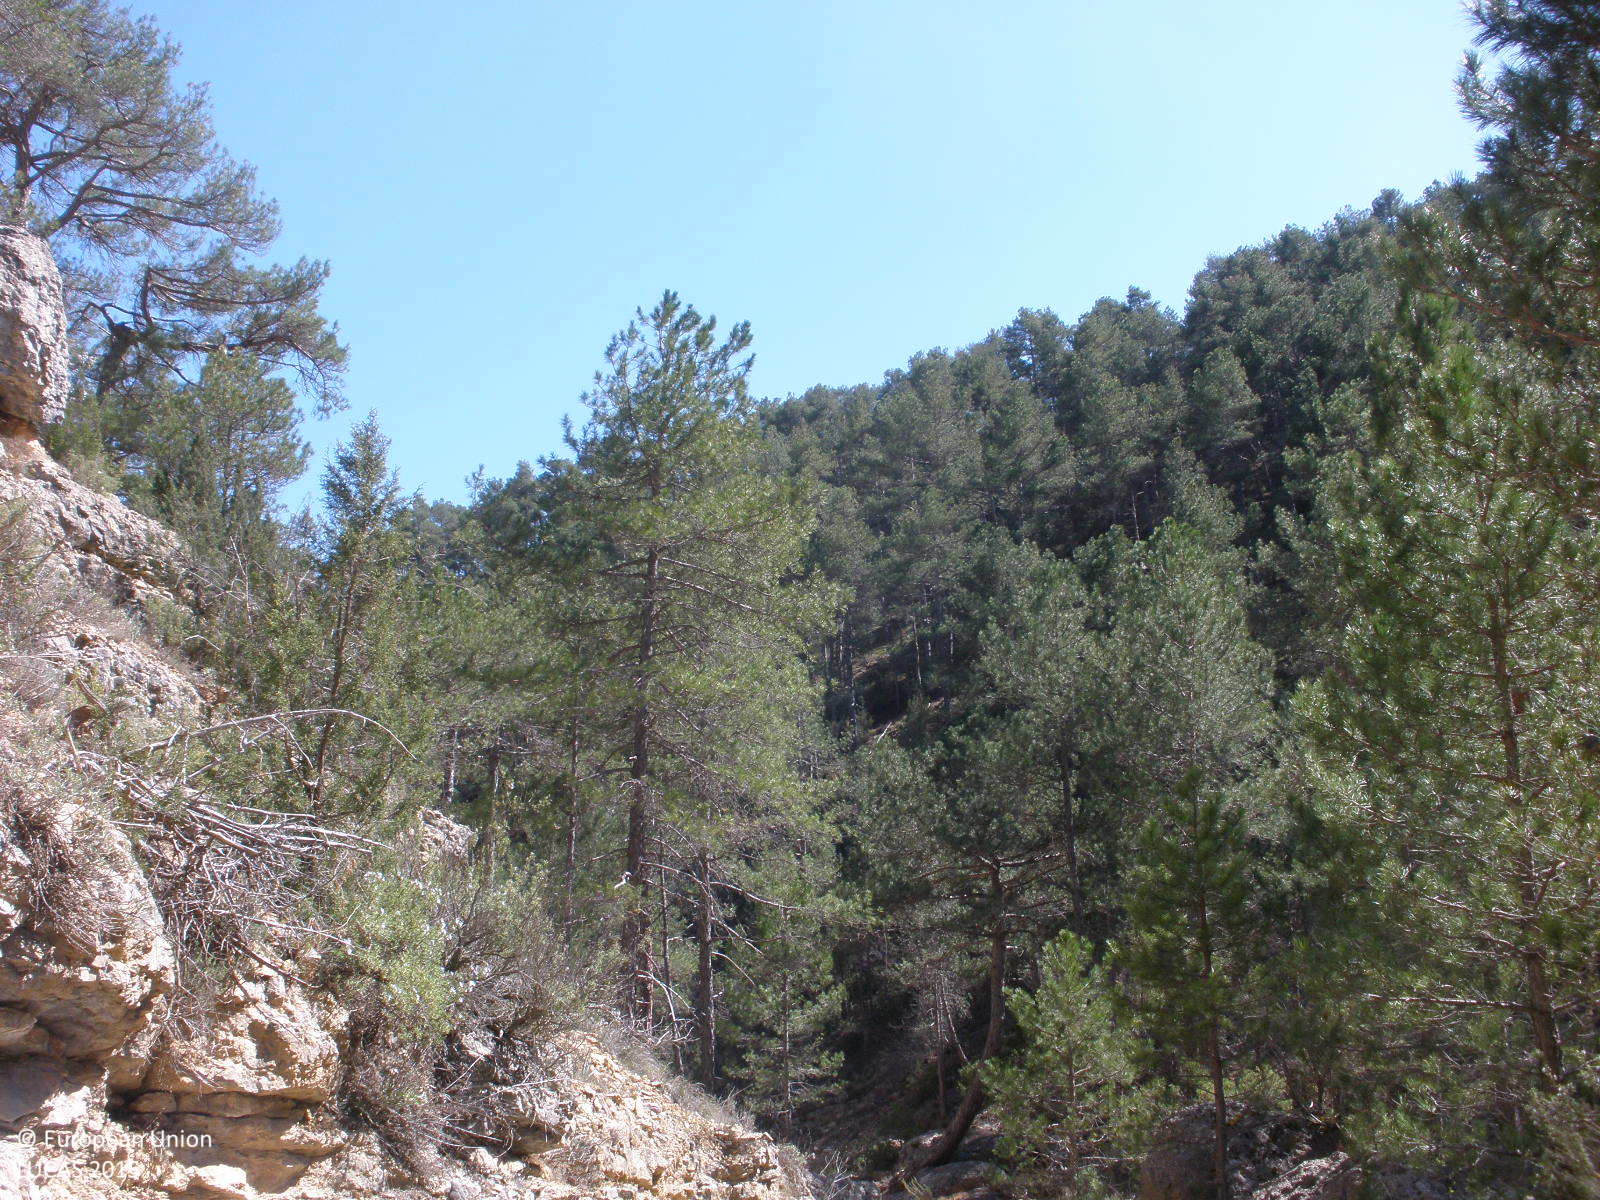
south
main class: Woodland
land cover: Pine dominated coniferous woodland
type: coniferous forest of the mediterranean region
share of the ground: 25 - 50 %
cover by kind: coniferous forest trees 40 %, shrubs 40 %, consolidated bare surface 20 %
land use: Semi-natural and natural areas not in use
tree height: > 5 m
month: April
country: ES
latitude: 40.2760
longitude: -1.2424
